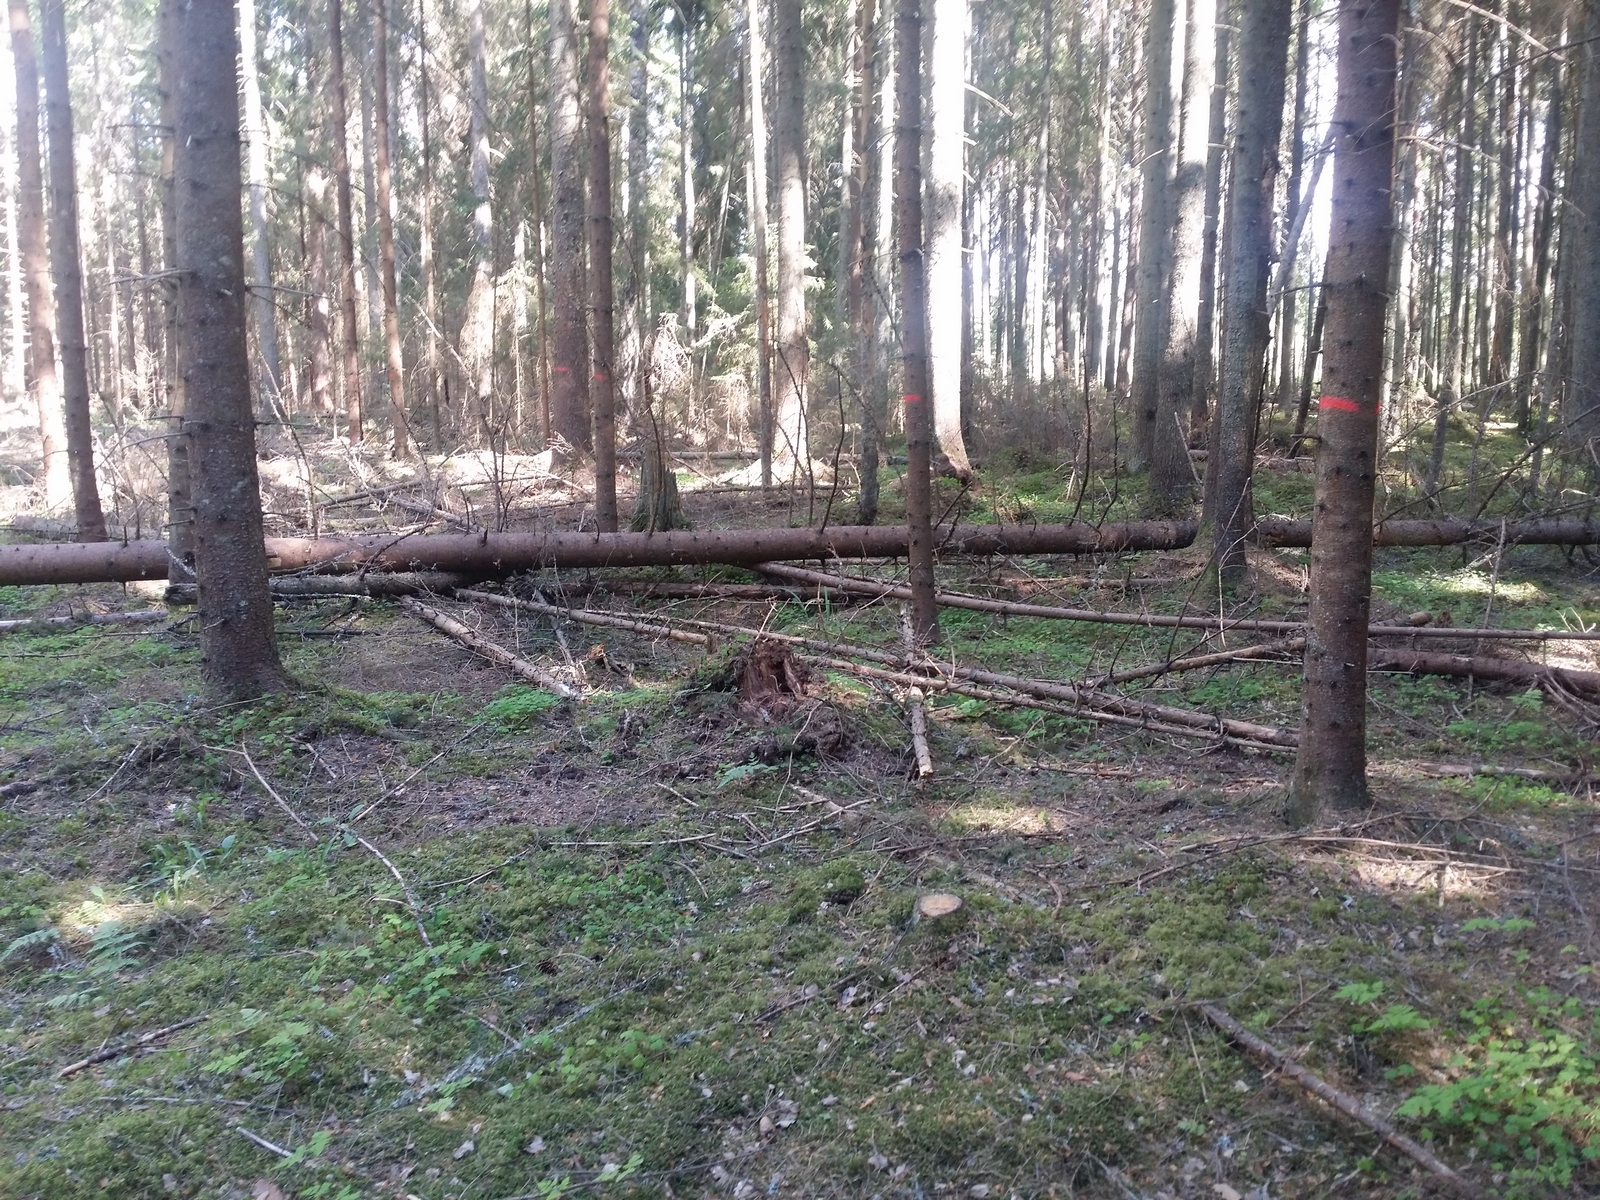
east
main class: Woodland
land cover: Spruce dominated coniferous woodland
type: hemiboreal forest and nemoral coniferous forest and mixed broadleaved-coniferous forest
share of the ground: > 75 %
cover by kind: coniferous forest trees 75 %, lichens and mosses 15 %, herbaceous plants 10 %
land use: Forestry
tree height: > 5 m
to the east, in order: Spruce dominated coniferous woodland; Other coniferous woodland; Spruce dominated coniferous woodland; Spontaneously vegetated surfaces; Ditches and canals; Spruce dominated coniferous woodland
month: June
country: LV
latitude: 57.3258
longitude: 26.4343
